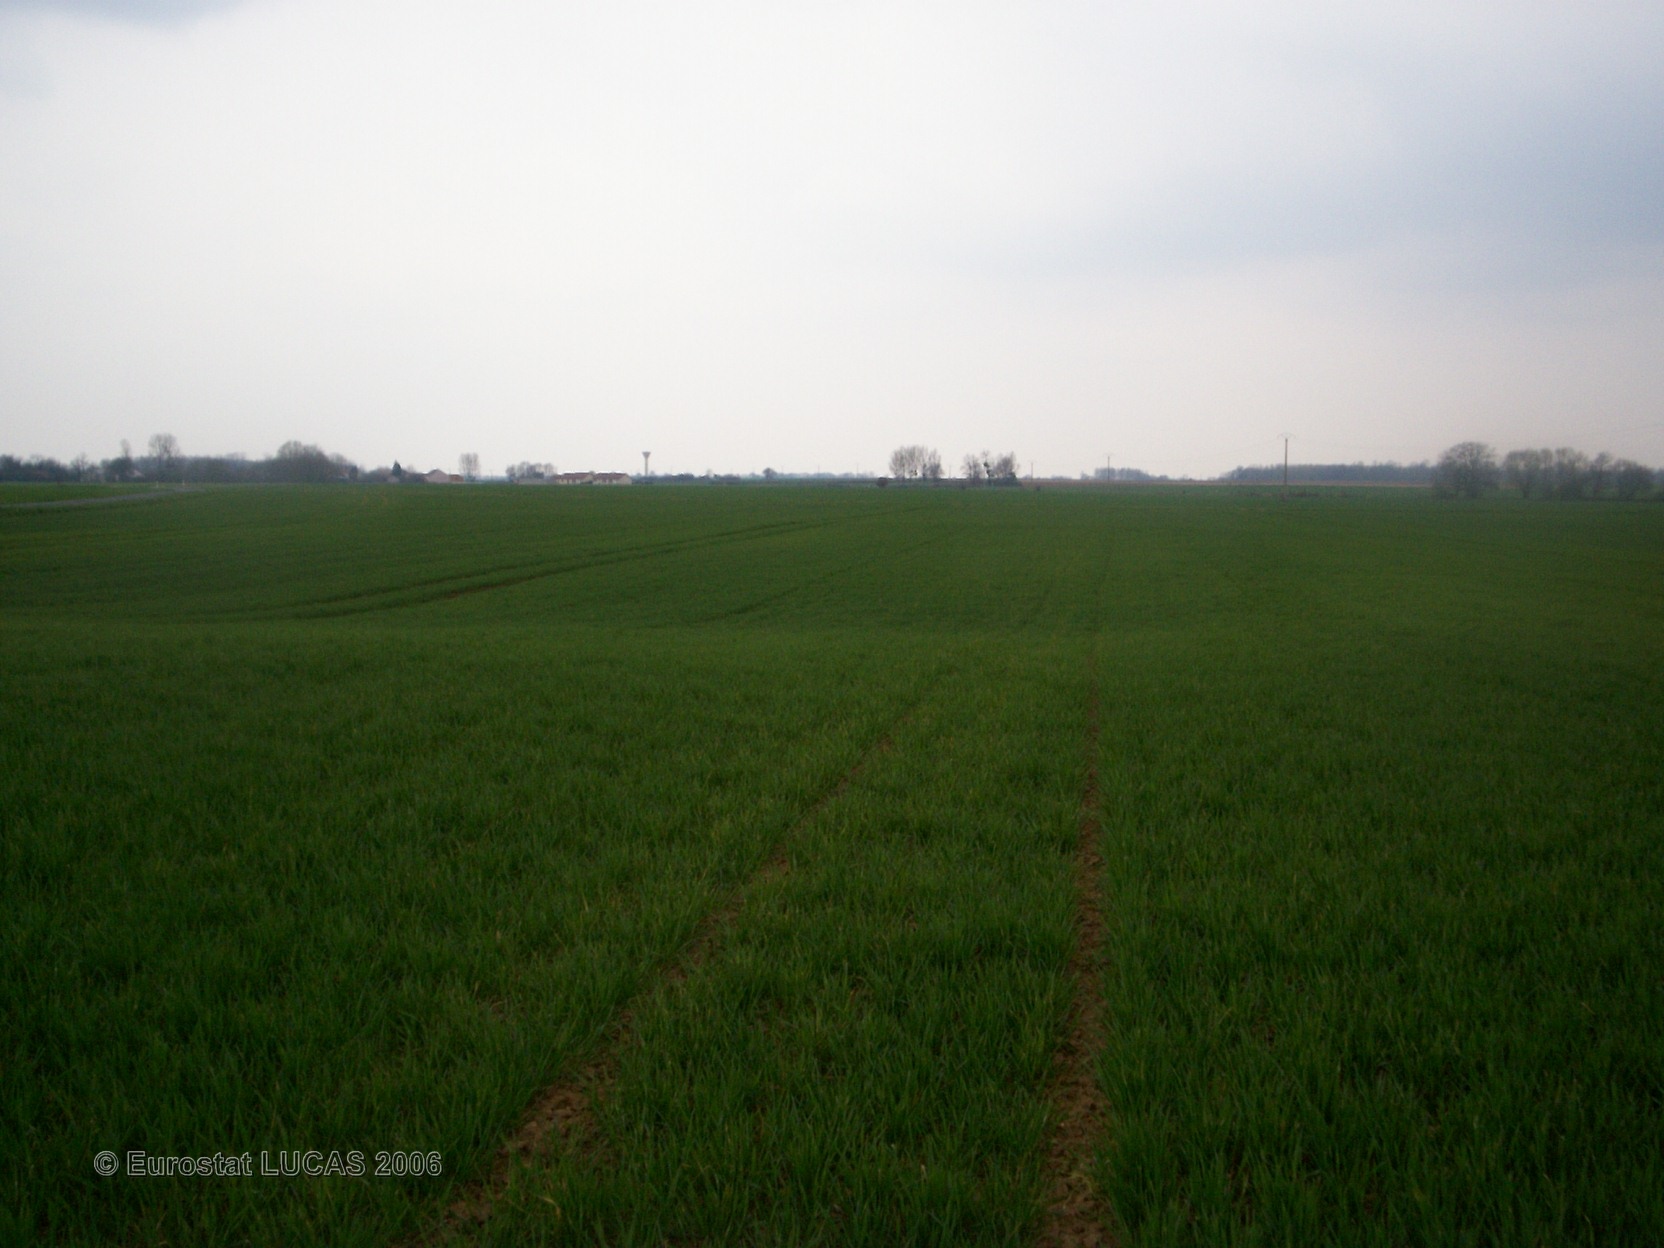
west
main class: Cropland
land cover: Common wheat
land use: Agriculture (excluding fallow land and kitchen gardens)
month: April
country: FR
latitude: 48.6802
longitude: 4.8503
